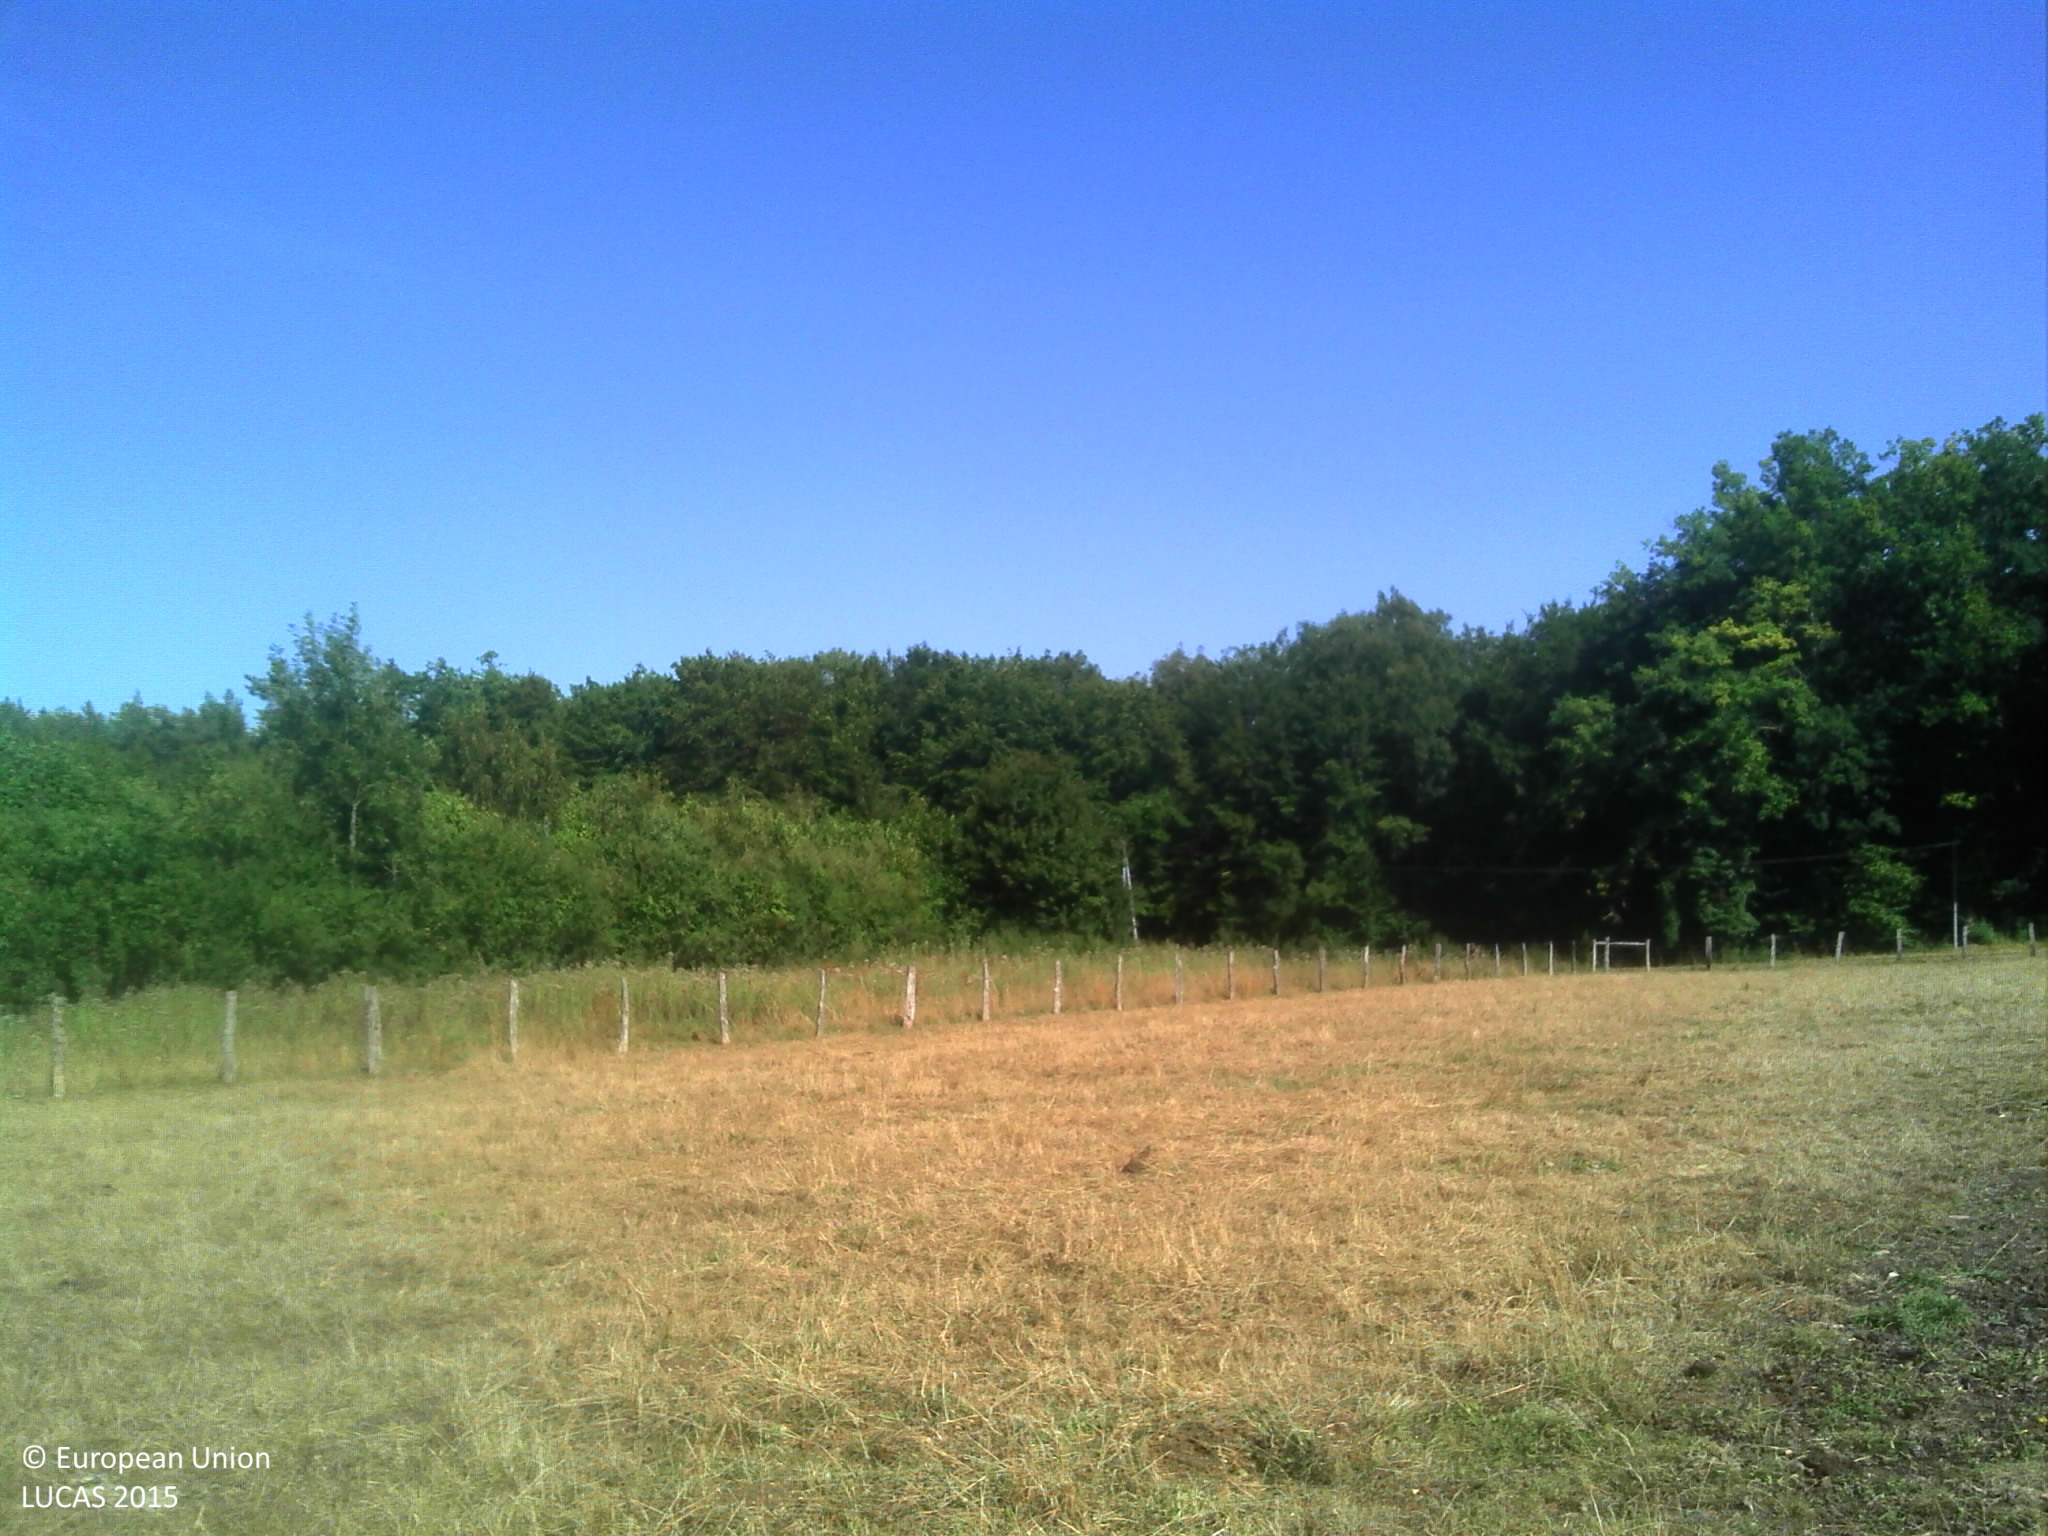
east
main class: Grassland
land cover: Grassland without tree/shrub cover
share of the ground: > 75 %
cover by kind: herbaceous plants 100 %
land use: Agriculture (excluding fallow land and kitchen gardens)
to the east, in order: Grassland without tree/shrub cover; Fences; Grassland without tree/shrub cover; Broadleaved woodland; Ditches and canals; Grass margins; Paved roads, cycling and walking lanes; Grass margins; Ditches and canals; Electric lines; Grassland without tree/shrub cover; Broadleaved woodland
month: August
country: FR
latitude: 47.7531
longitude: 5.0776
